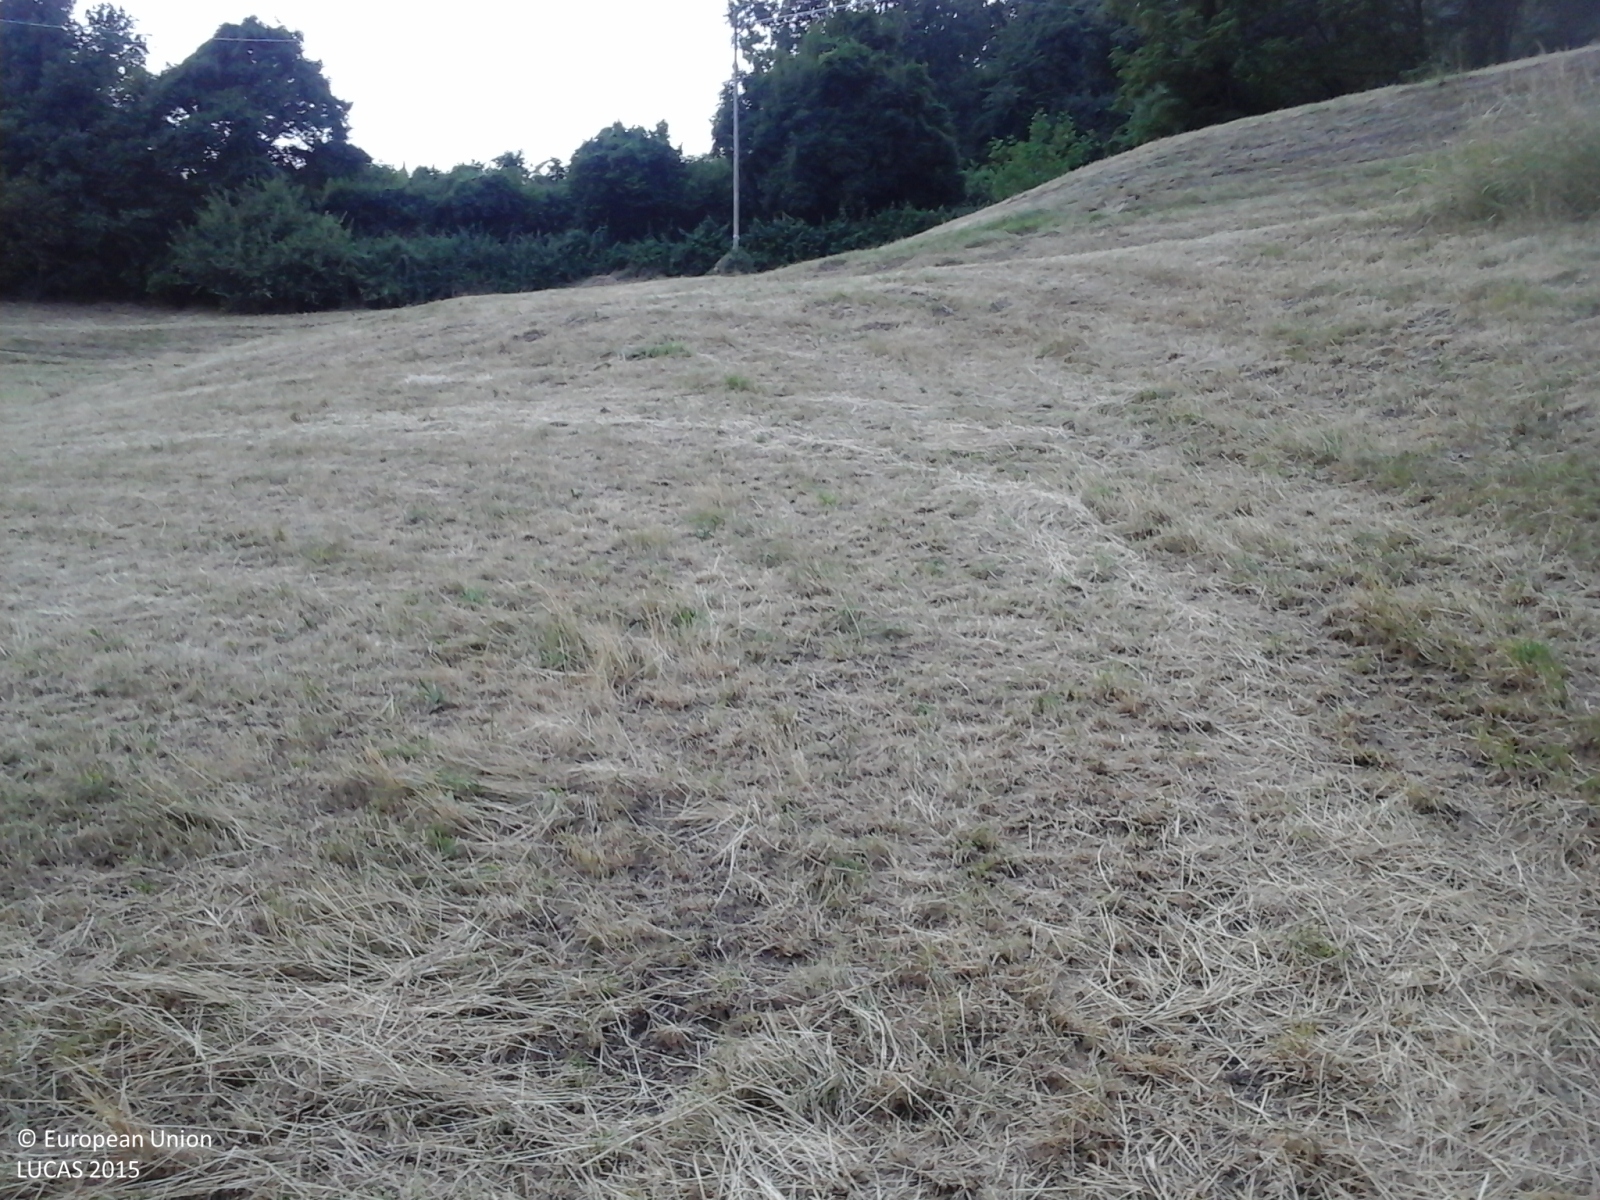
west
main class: Grassland
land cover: Grassland without tree/shrub cover
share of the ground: > 75 %
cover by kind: herbaceous plants 100 %
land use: Agriculture (excluding fallow land and kitchen gardens)
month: June
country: IT
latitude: 45.6273
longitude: 10.8324
